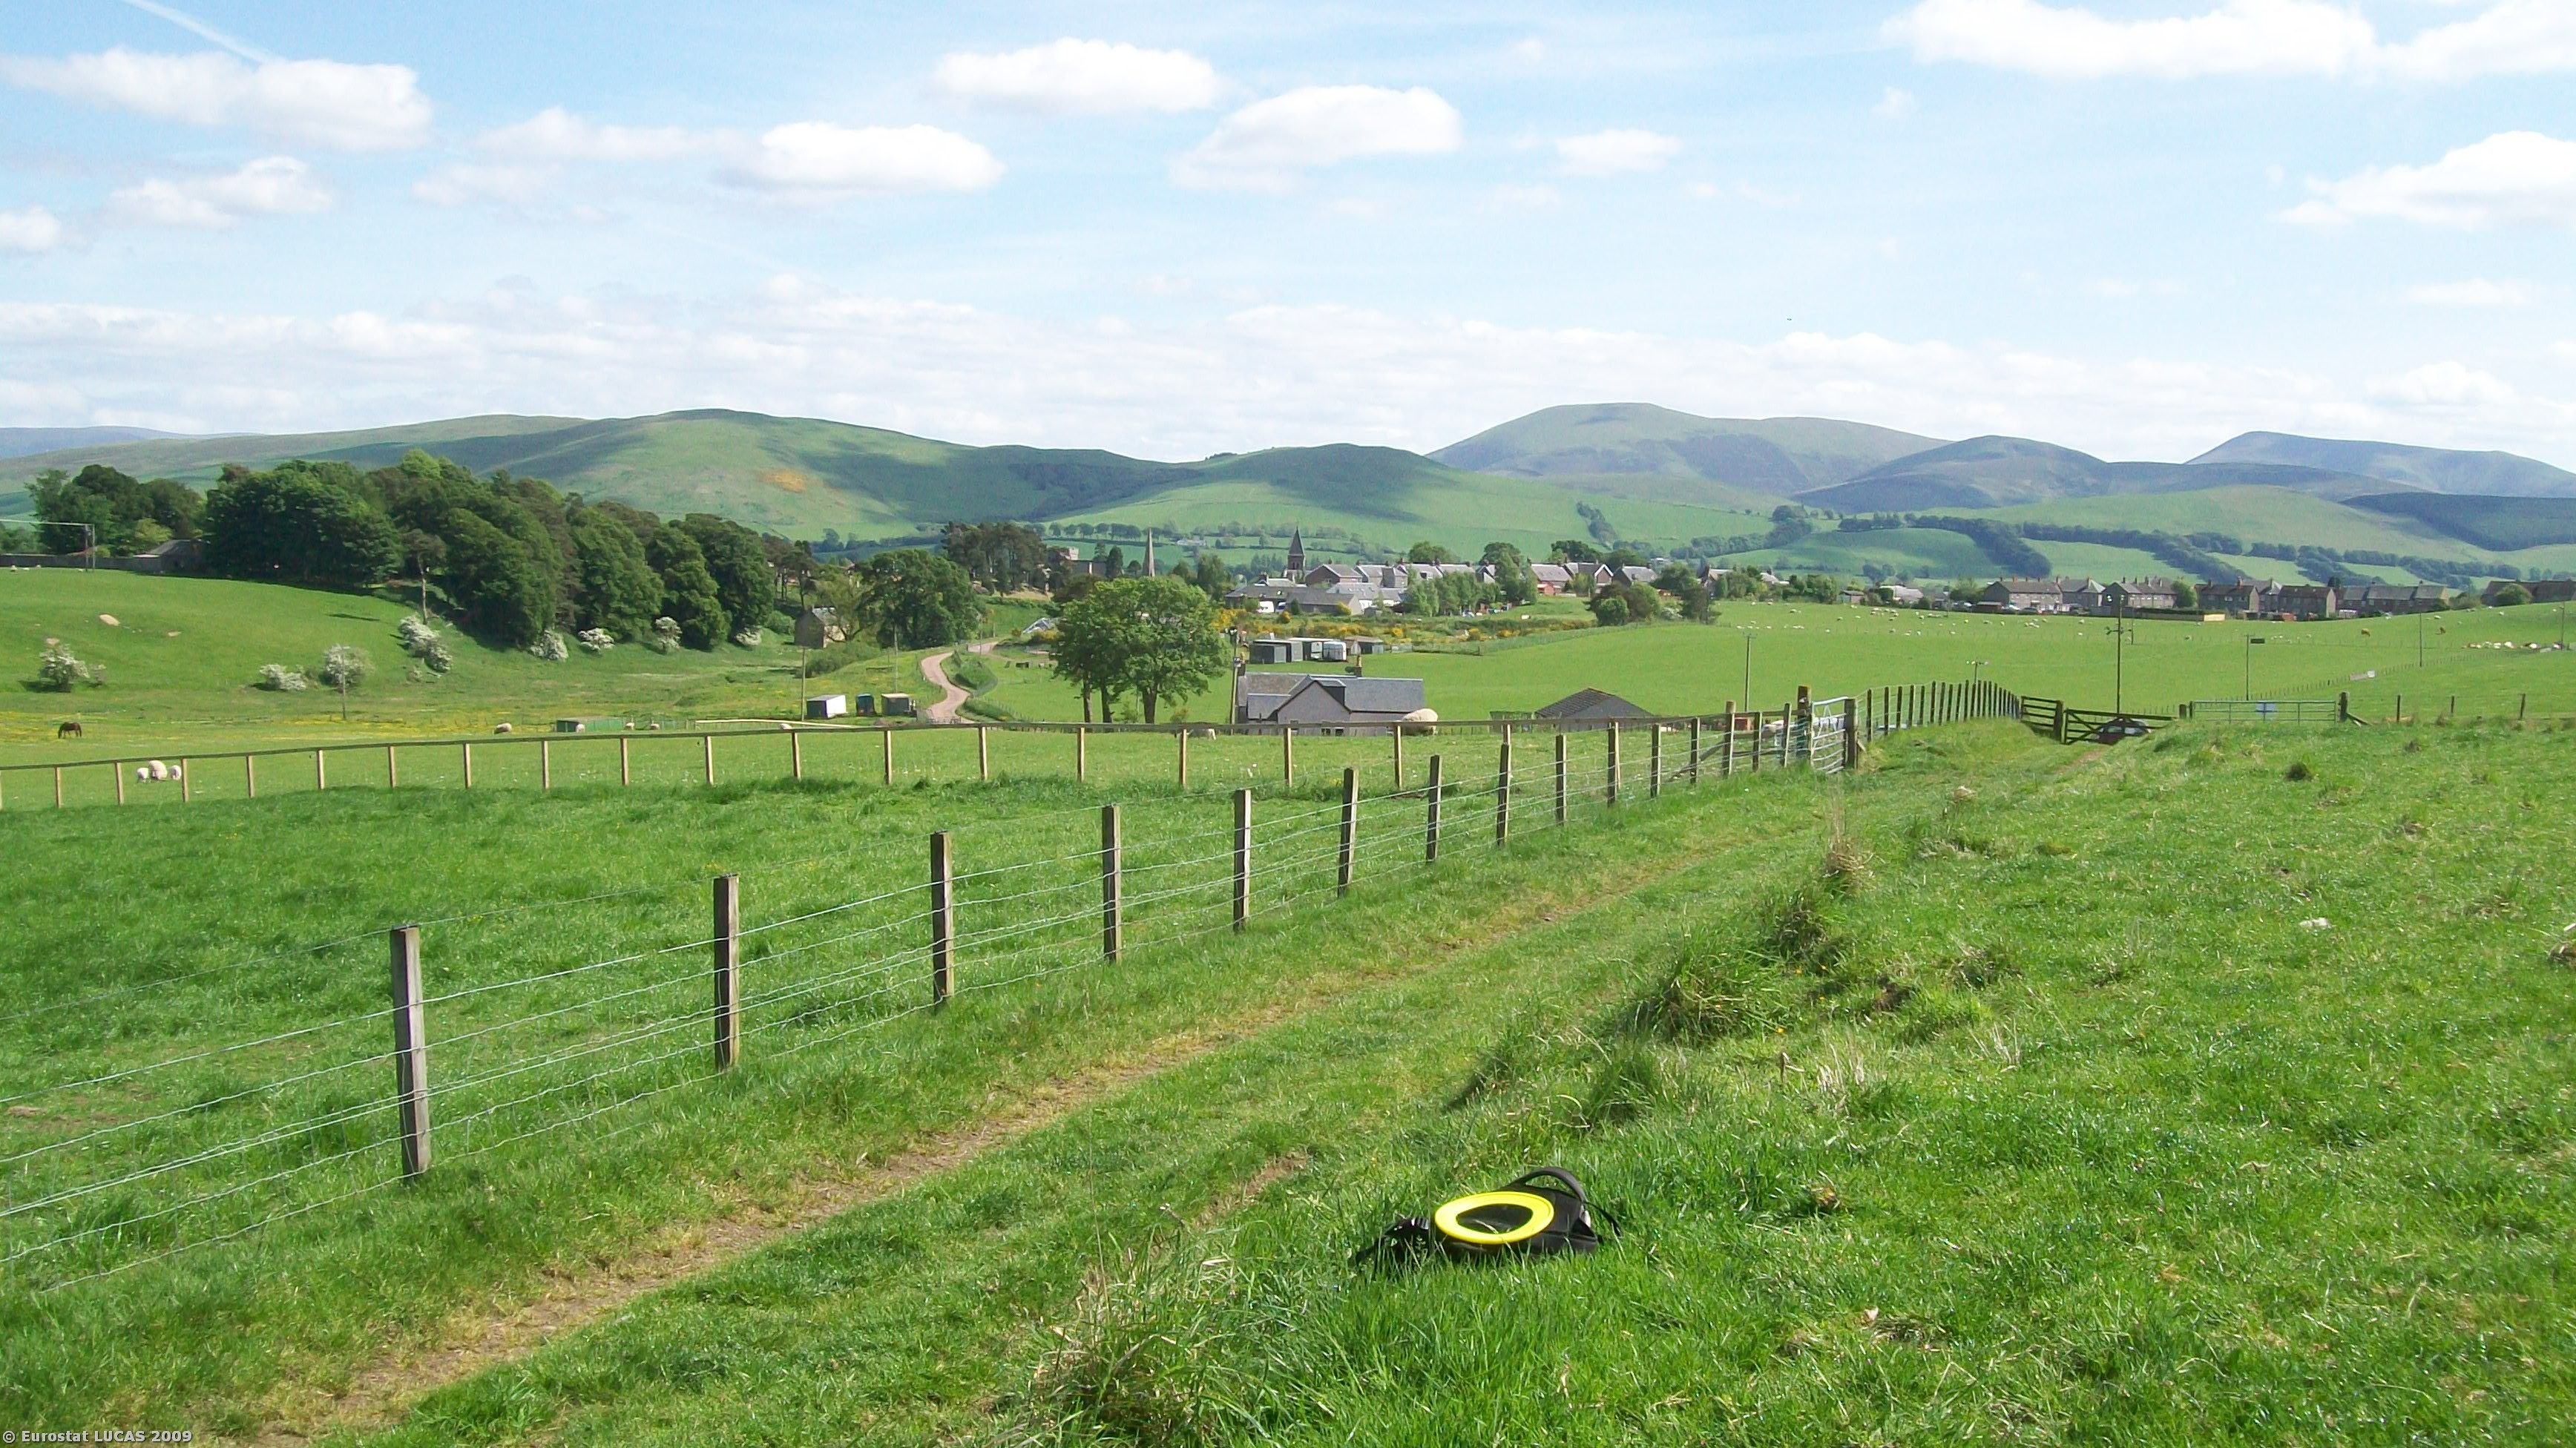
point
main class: Shrubland
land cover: Shrubland without tree cover
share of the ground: > 75 %
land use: Agriculture (excluding fallow land and kitchen gardens)
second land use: Forestry
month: June
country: GB
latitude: 55.6308
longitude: -3.5325
